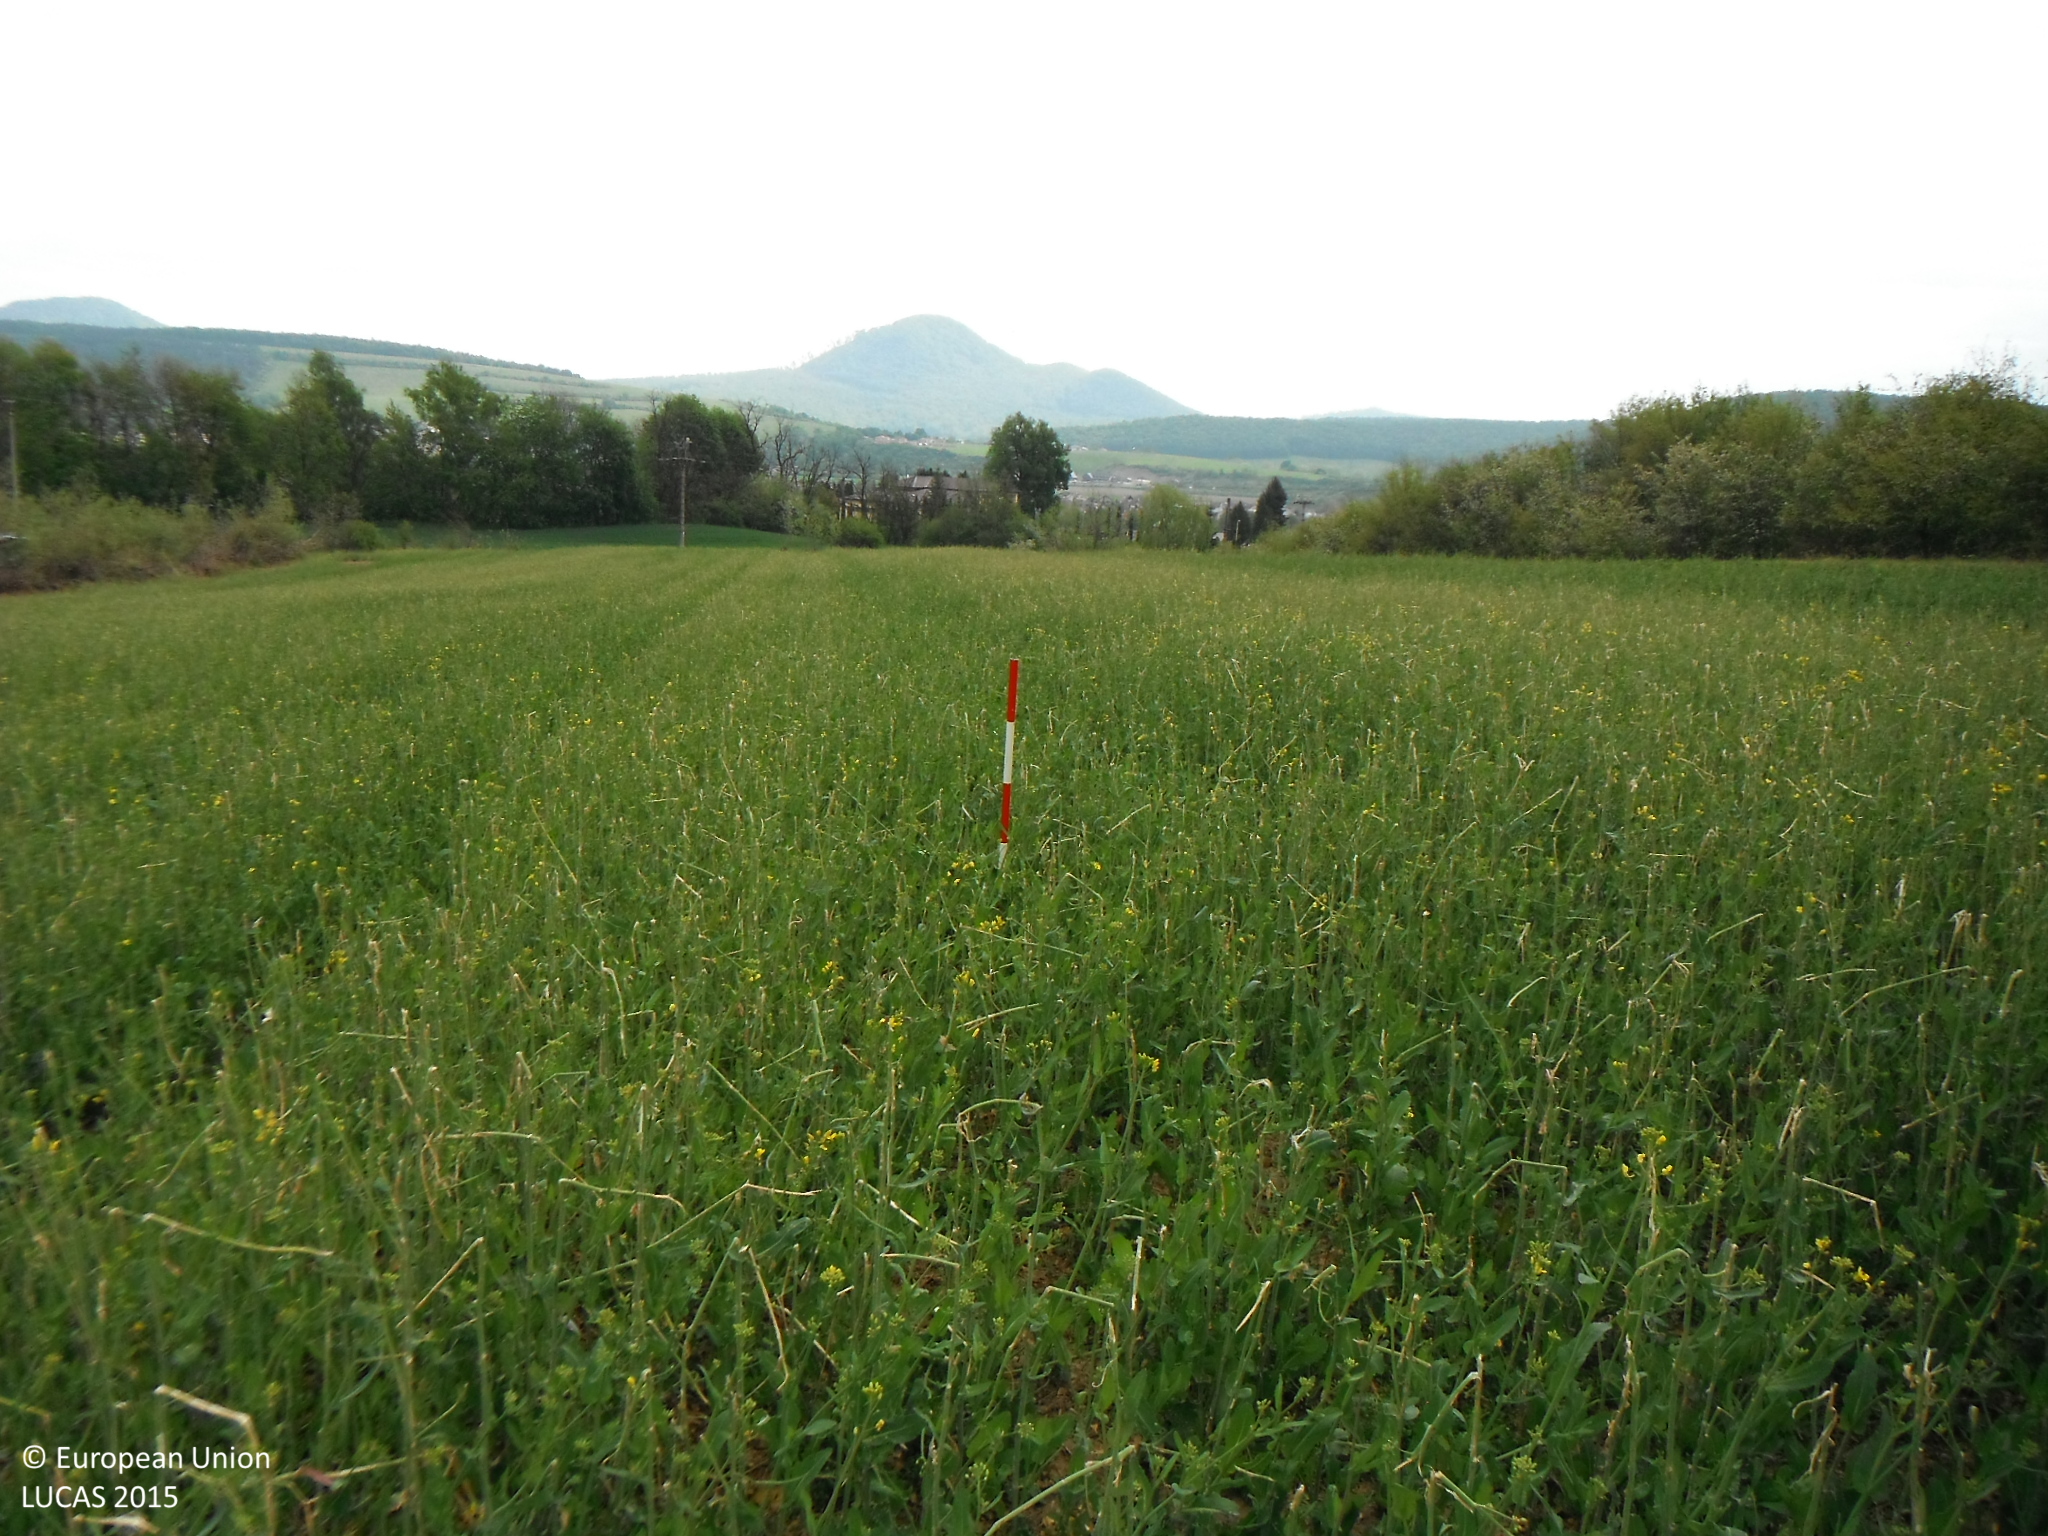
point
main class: Cropland
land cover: Rape and turnip rape
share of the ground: > 75 %
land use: Agriculture (excluding fallow land and kitchen gardens)
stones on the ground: < 10 %
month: May
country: SK
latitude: 49.0320
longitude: 21.1917
